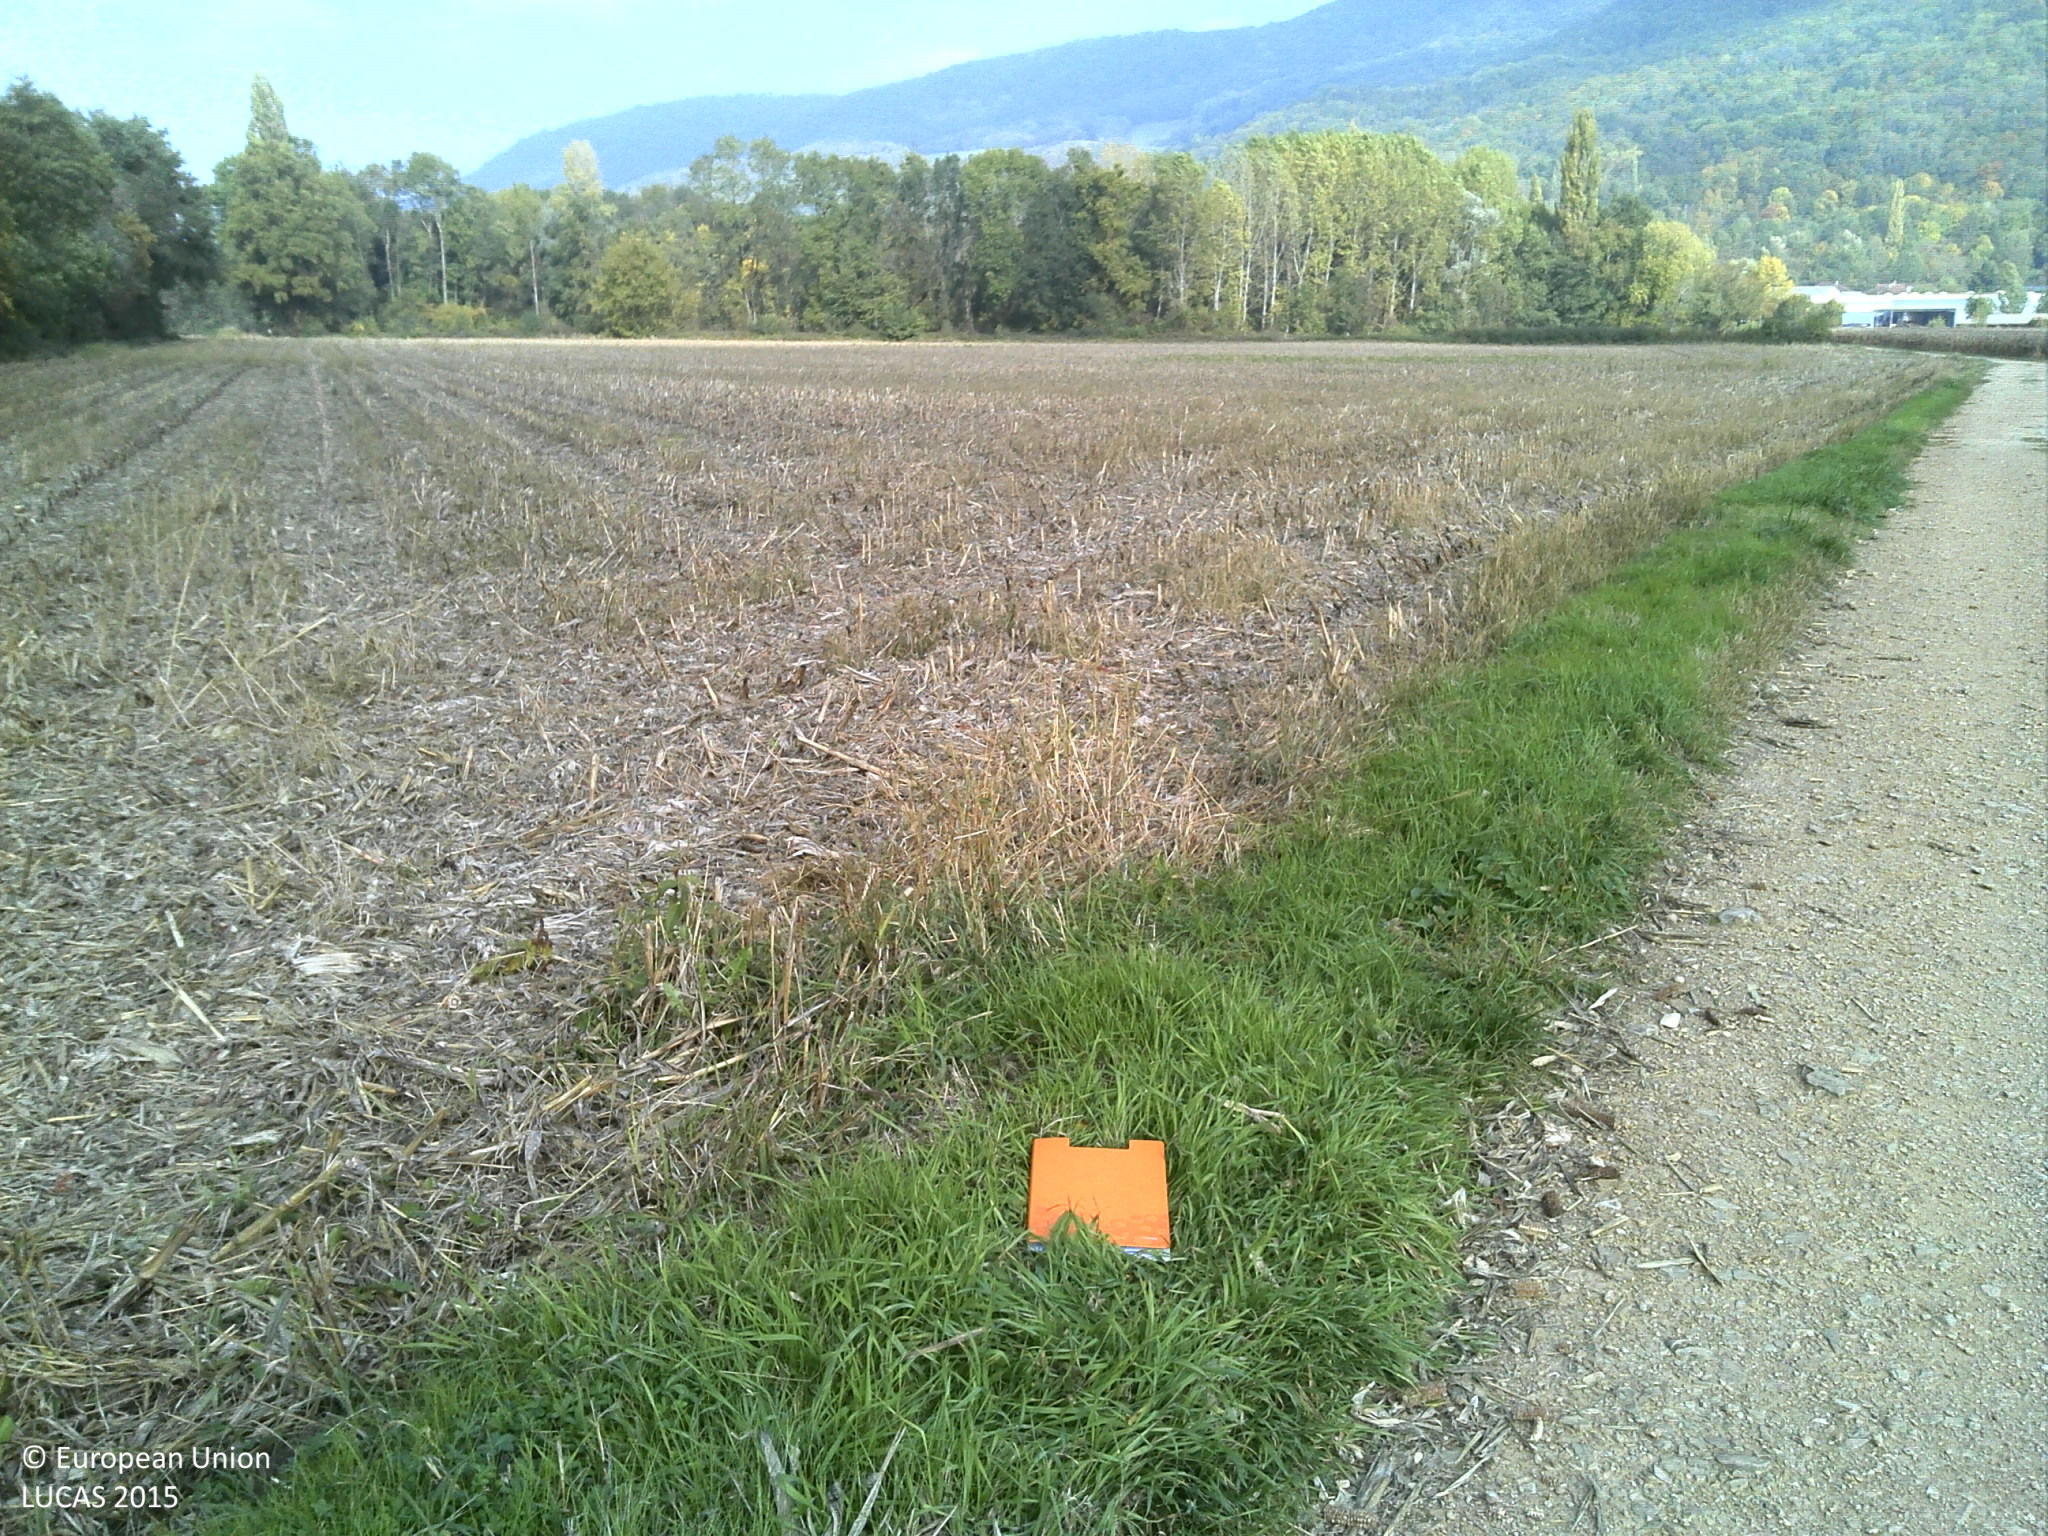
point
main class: Cropland
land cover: Maize
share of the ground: < 10 %
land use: Agriculture (excluding fallow land and kitchen gardens)
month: October
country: FR
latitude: 45.8893
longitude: 5.3516
